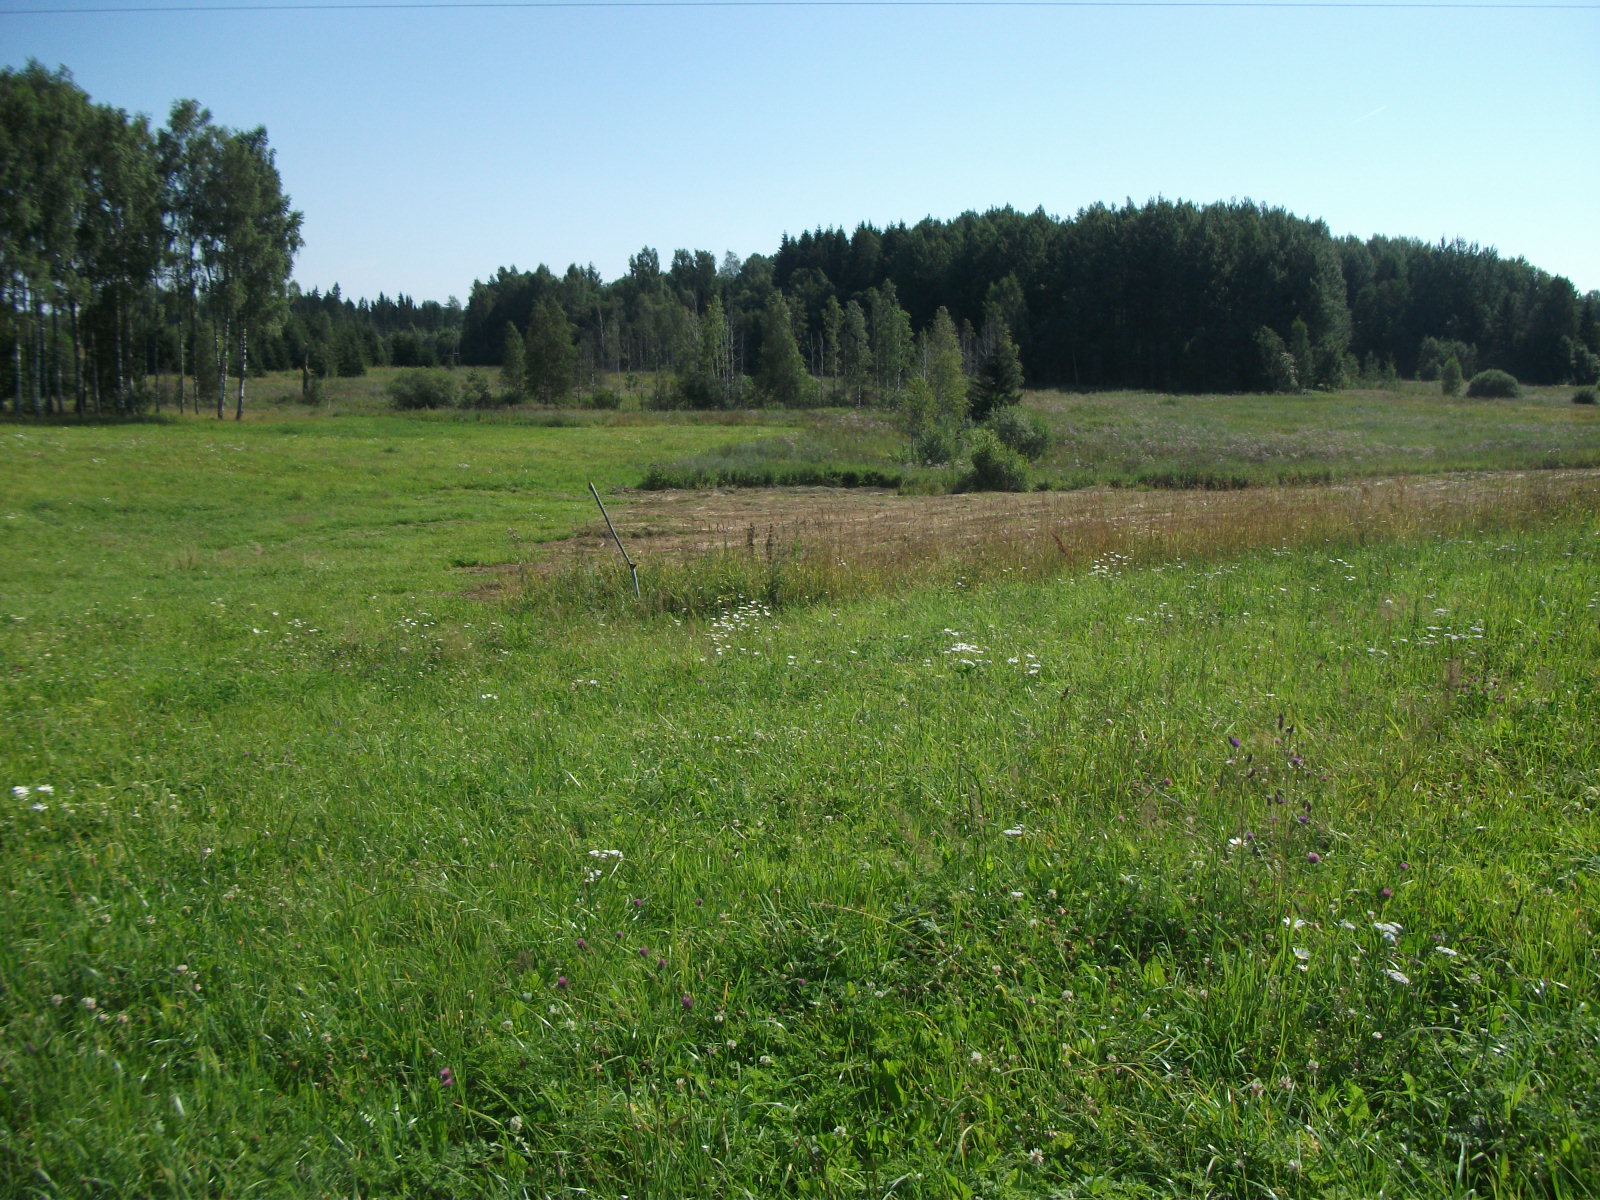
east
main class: Grassland
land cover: Grassland without tree/shrub cover
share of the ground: > 75 %
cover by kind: herbaceous plants 100 %
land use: Agriculture (excluding fallow land and kitchen gardens)
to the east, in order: Grassland without tree/shrub cover; Electric lines; Grassland without tree/shrub cover; Spontaneously vegetated surfaces; Abandoned hedges; Ditches and canals; Abandoned hedges; Spontaneously vegetated surfaces; Abandoned hedges
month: August
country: LV
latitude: 56.9284
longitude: 25.7845
